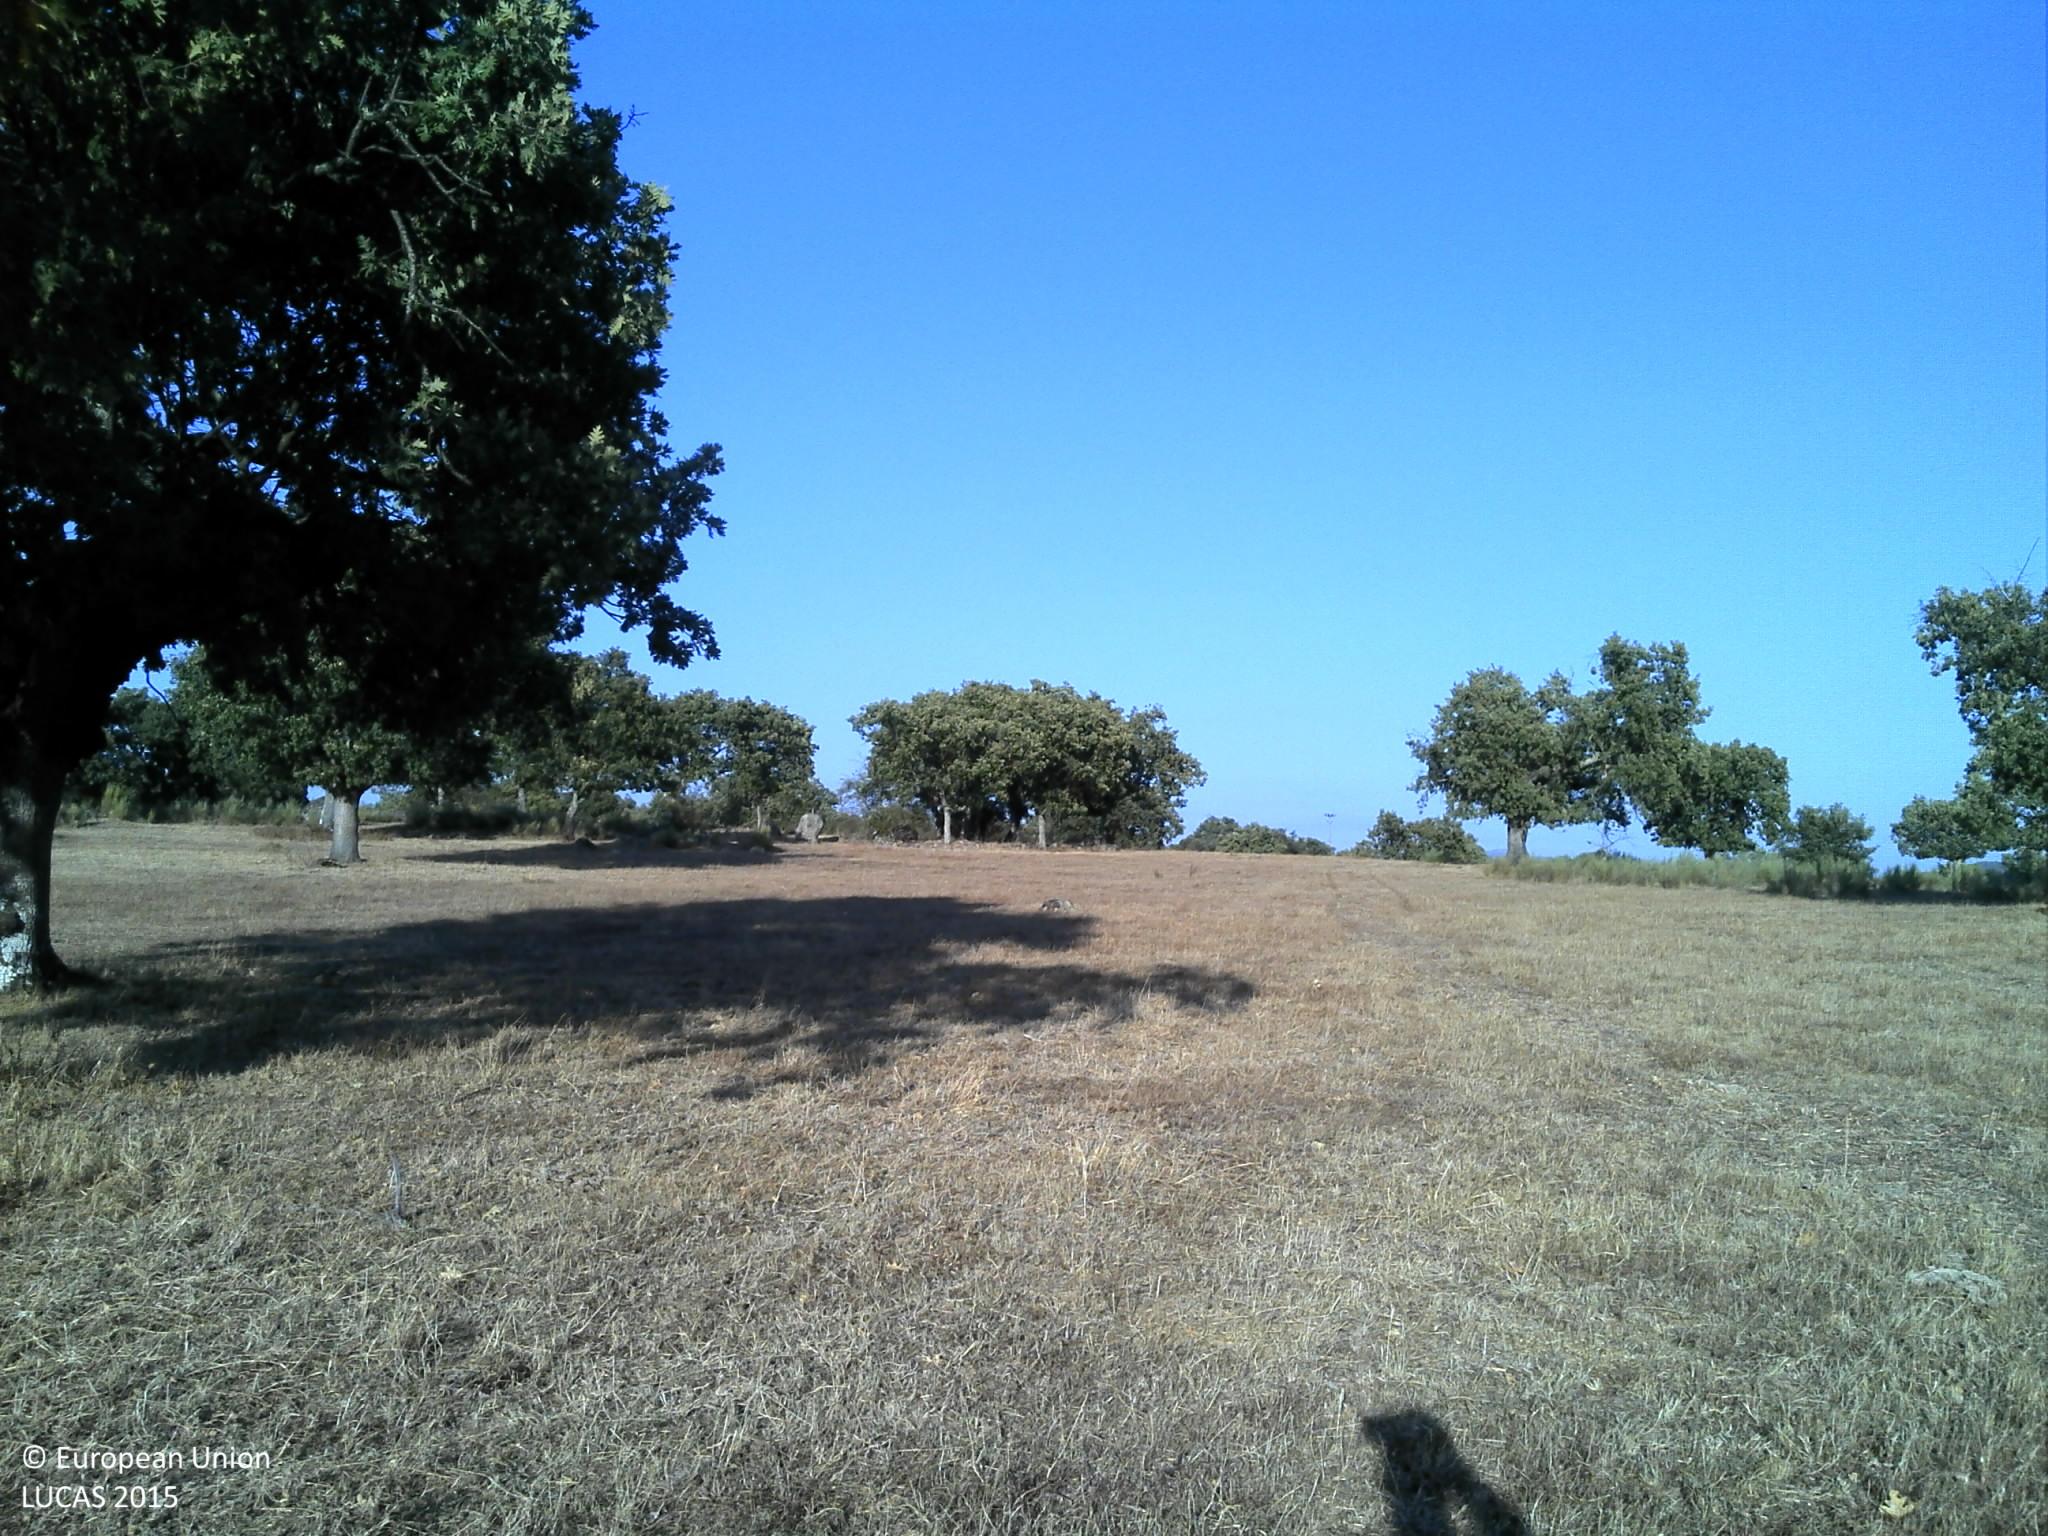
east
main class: Woodland
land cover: Broadleaved woodland
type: broadleaved evergreen forest
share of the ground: 10 - 25 %
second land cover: Grassland without tree/shrub cover
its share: 10 - 25 %
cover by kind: unconsolidated bare surface 80 %, broadleaved forest trees 10 %, herbaceous plants 10 %
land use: Forestry
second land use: Agriculture (excluding fallow land and kitchen gardens)
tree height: > 5 m
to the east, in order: Broadleaved woodland; Grassland without tree/shrub cover; Broadleaved woodland; Fences; Grass margins; Tracks; Grass margins; Fences; Spontaneously vegetated surfaces; Rock outcrops; Spontaneously vegetated surfaces
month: August
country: PT
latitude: 39.3533
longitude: -7.5569
